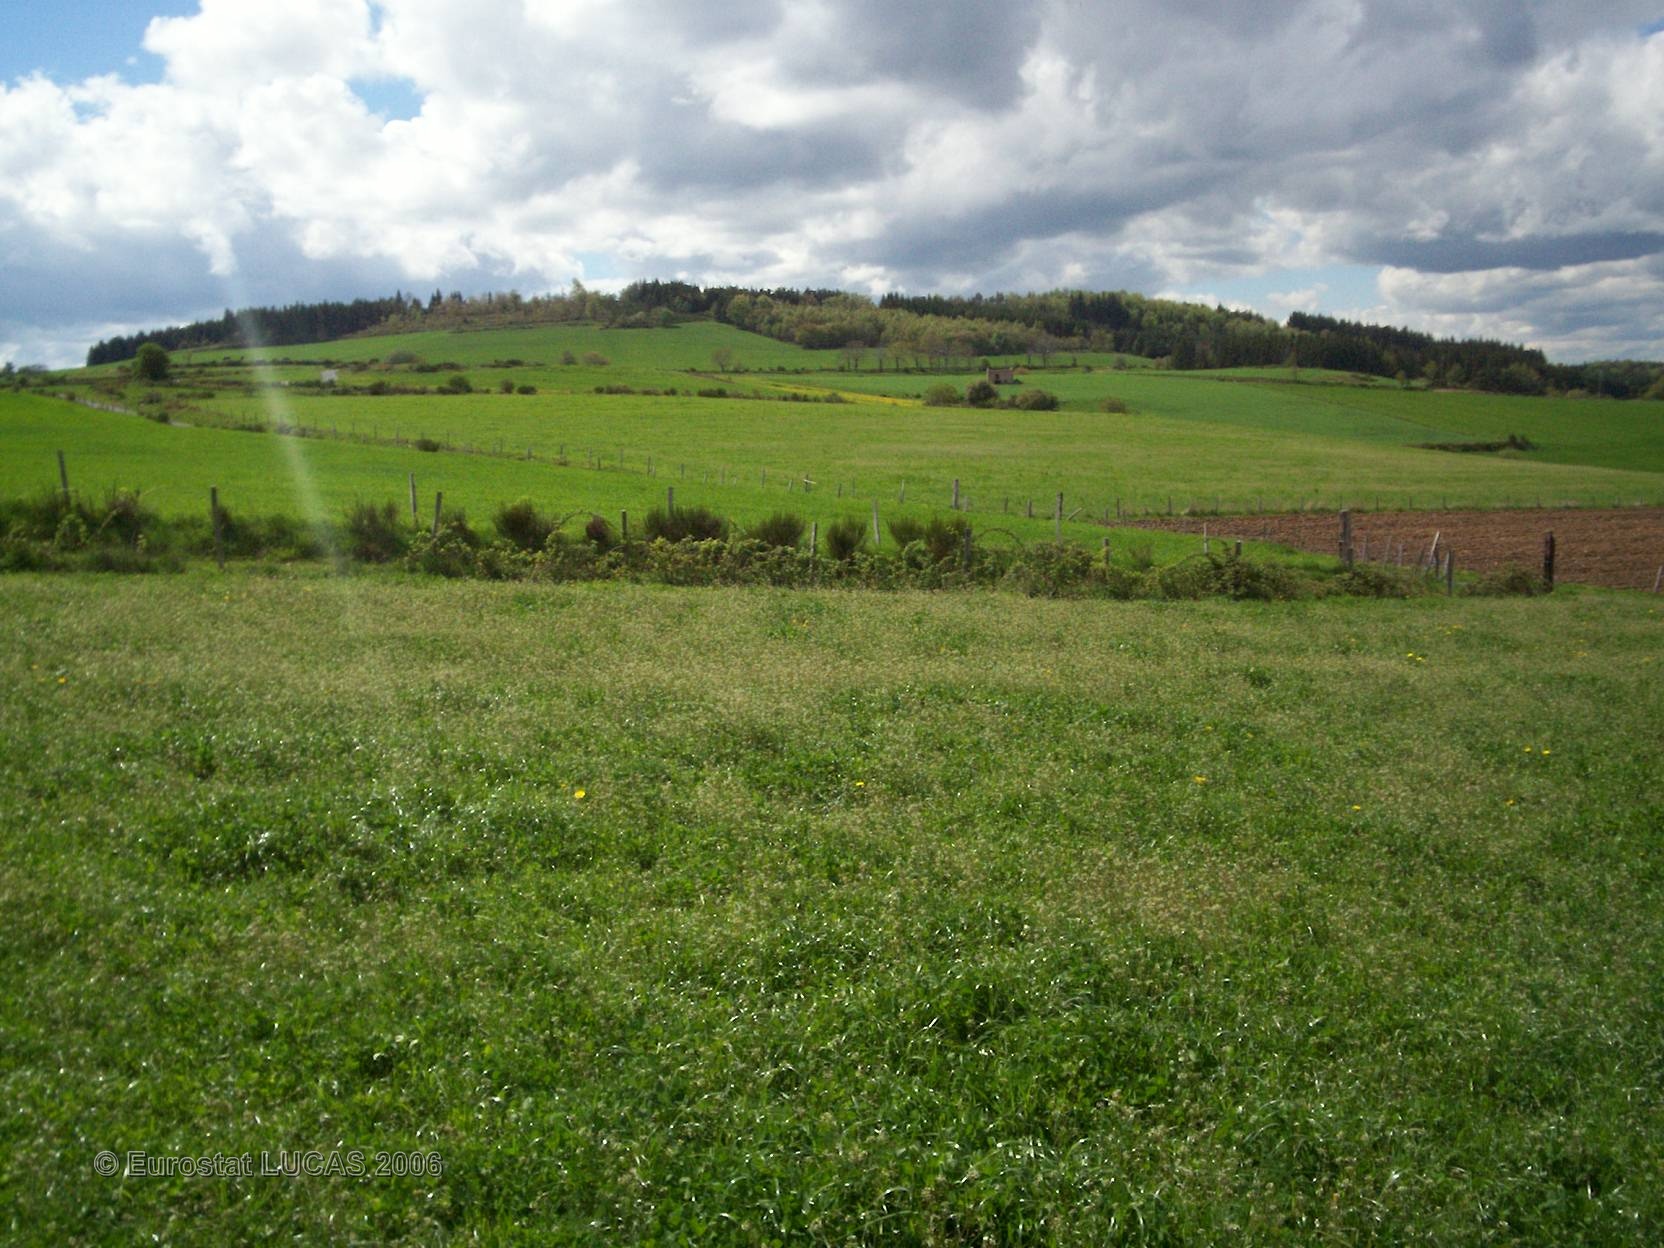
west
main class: Grassland
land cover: Grassland without tree/shrub cover
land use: Agriculture (excluding fallow land and kitchen gardens)
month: May
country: FR
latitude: 45.1859
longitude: 3.3462
